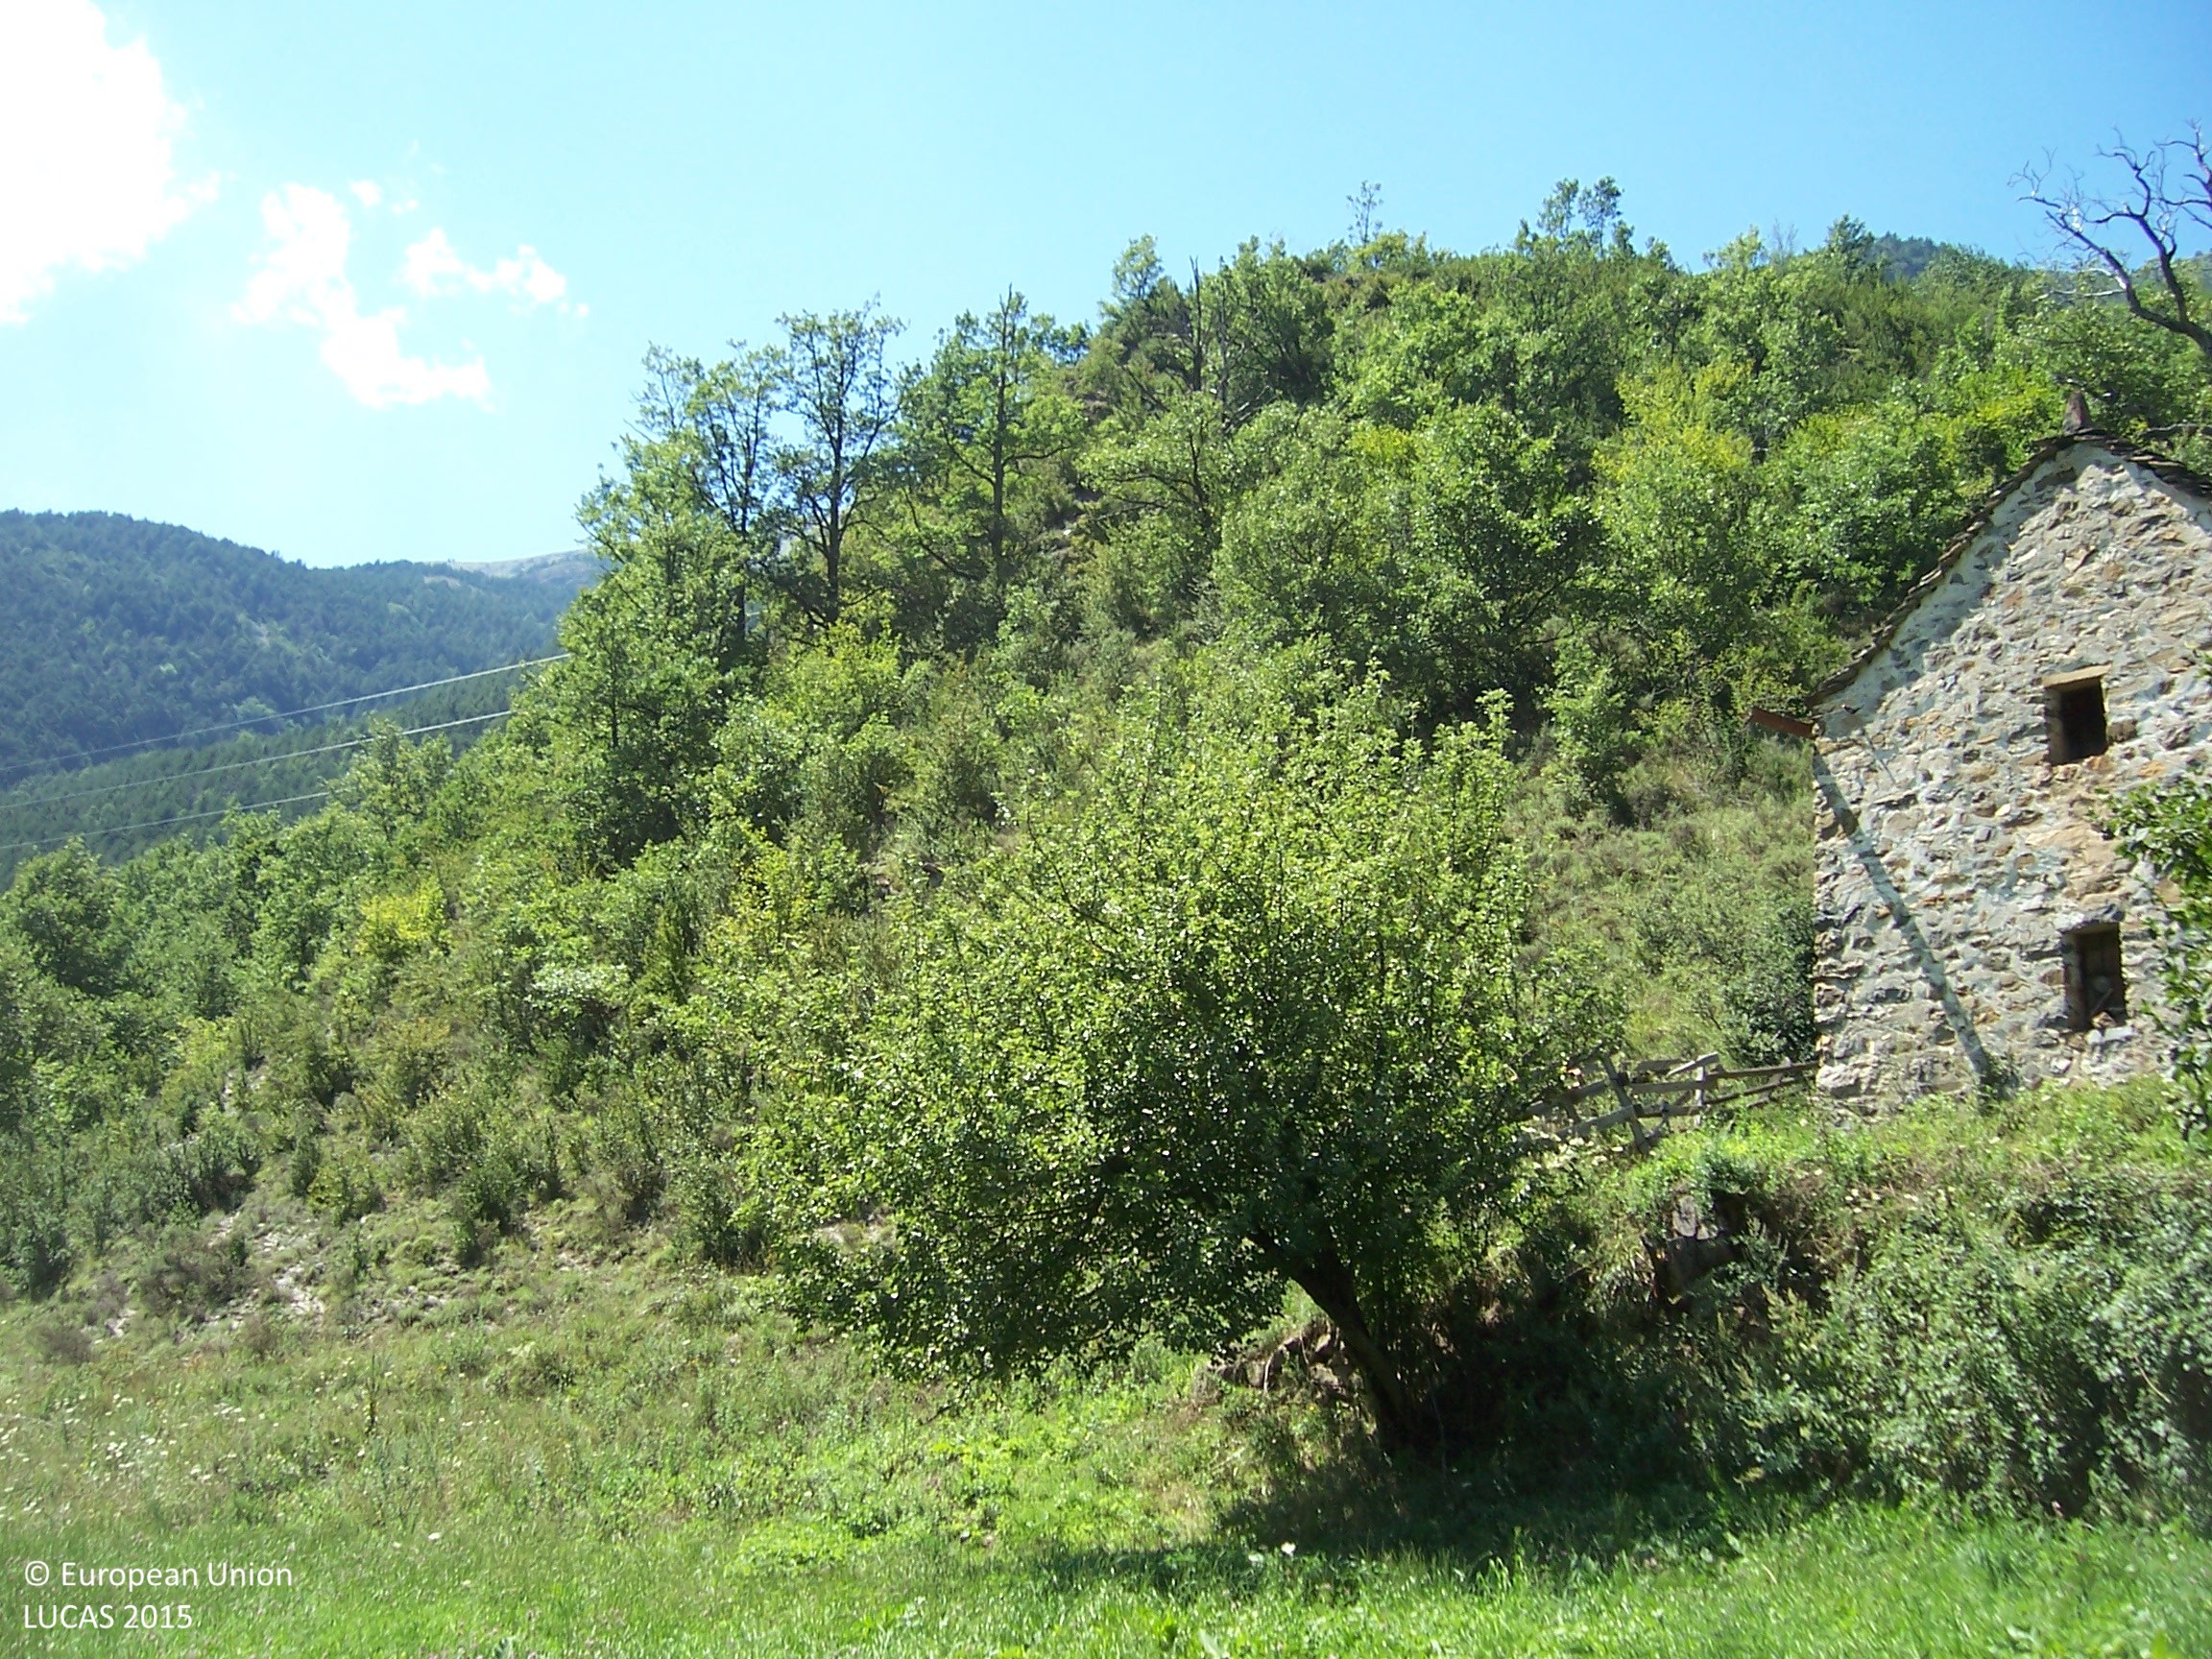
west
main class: Woodland
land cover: Pine dominated coniferous woodland
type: coniferous forest of the mediterranean region
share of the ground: > 75 %
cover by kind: coniferous forest trees 75 %, herbaceous plants 15 %, shrubs 10 %
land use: Semi-natural and natural areas not in use
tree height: > 5 m
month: August
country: ES
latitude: 42.6403
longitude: -0.0859
